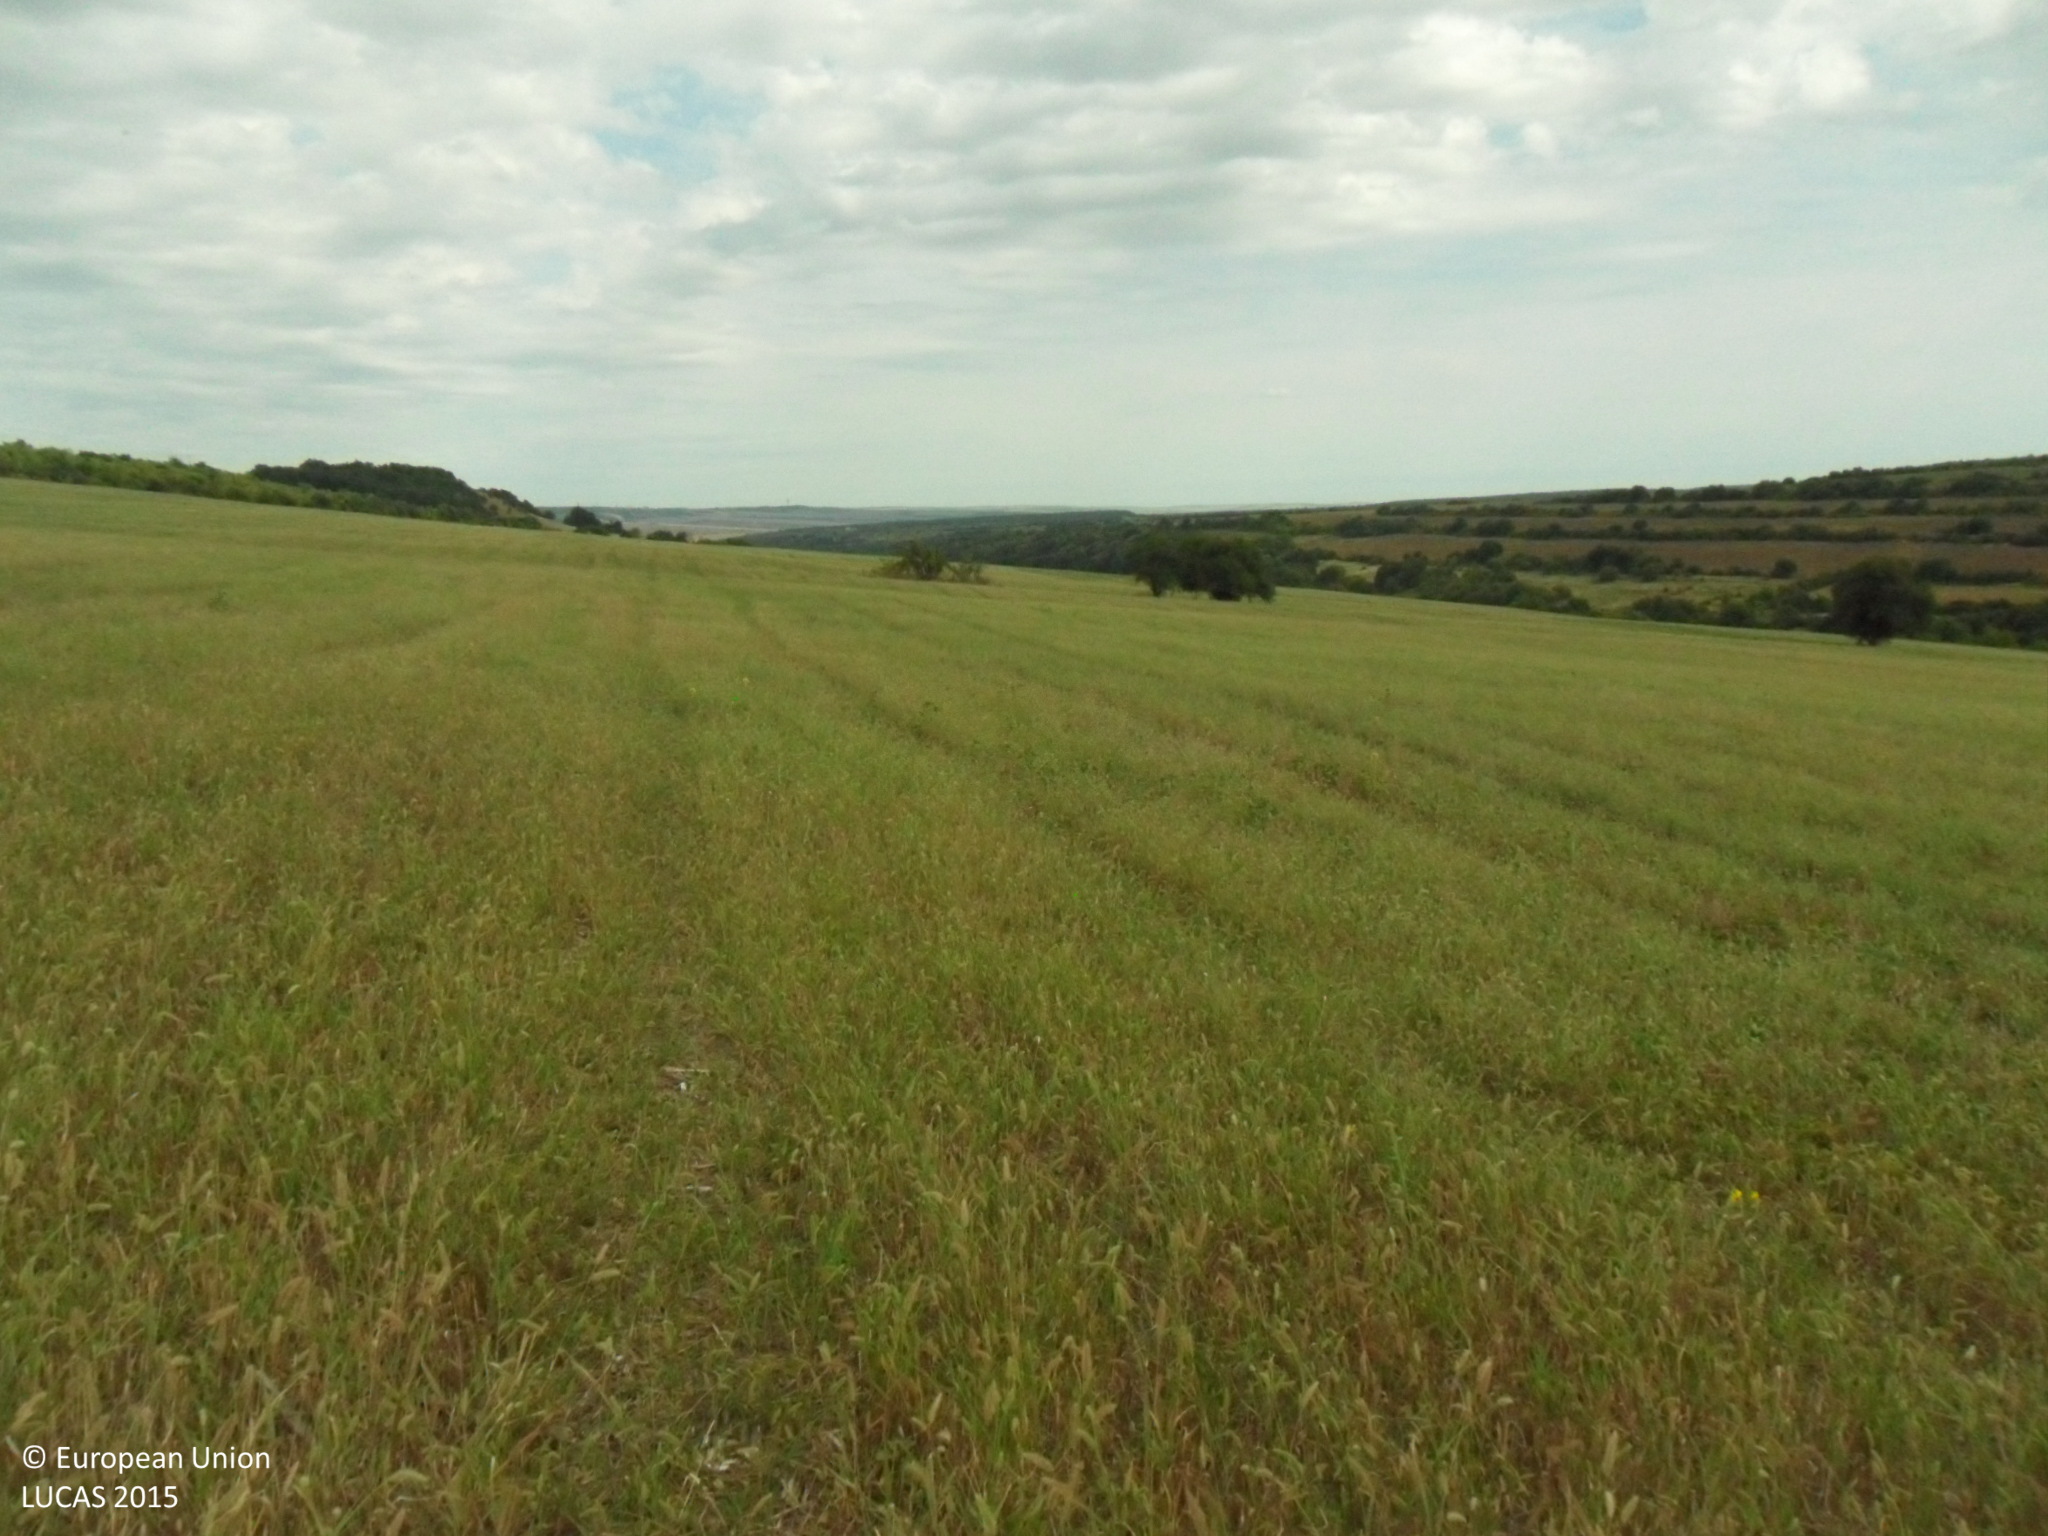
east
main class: Cropland
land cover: Common wheat
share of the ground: > 75 %
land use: Agriculture (excluding fallow land and kitchen gardens)
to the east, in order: Common wheat
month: September
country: BG
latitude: 43.5567
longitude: 26.3555
